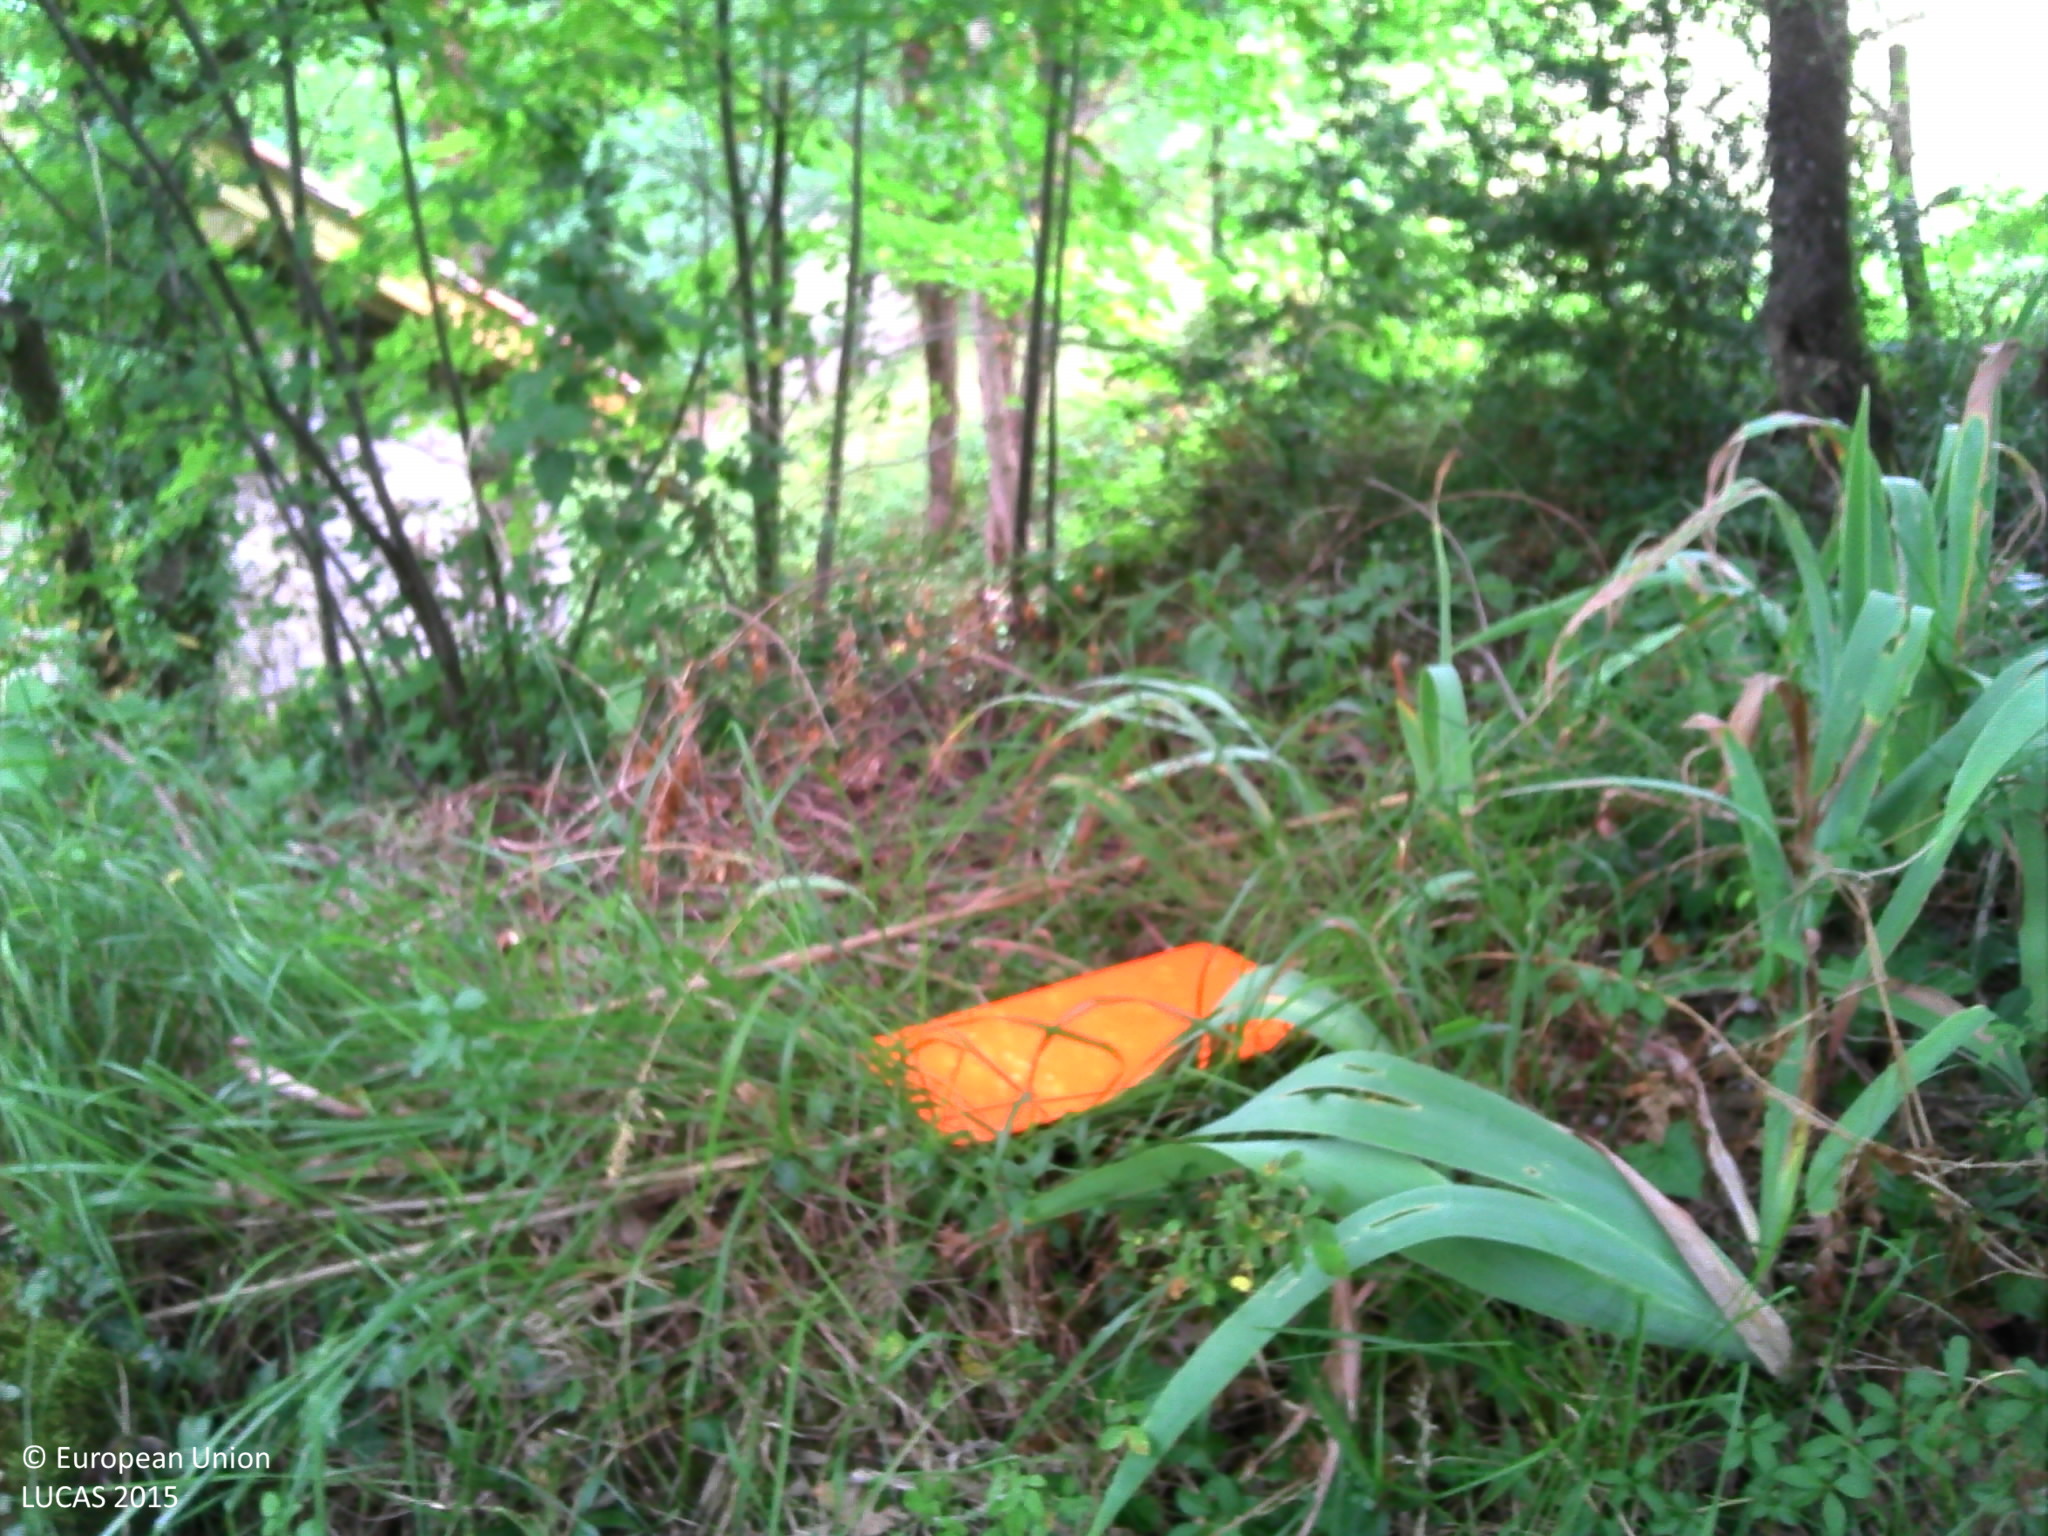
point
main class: Woodland
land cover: Broadleaved woodland
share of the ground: > 75 %
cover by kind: broadleaved forest trees 80 %, coniferous forest trees 10 %, herbaceous plants 10 %
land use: Semi-natural and natural areas not in use
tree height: > 5 m
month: July
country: FR
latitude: 45.3417
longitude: 5.6277
